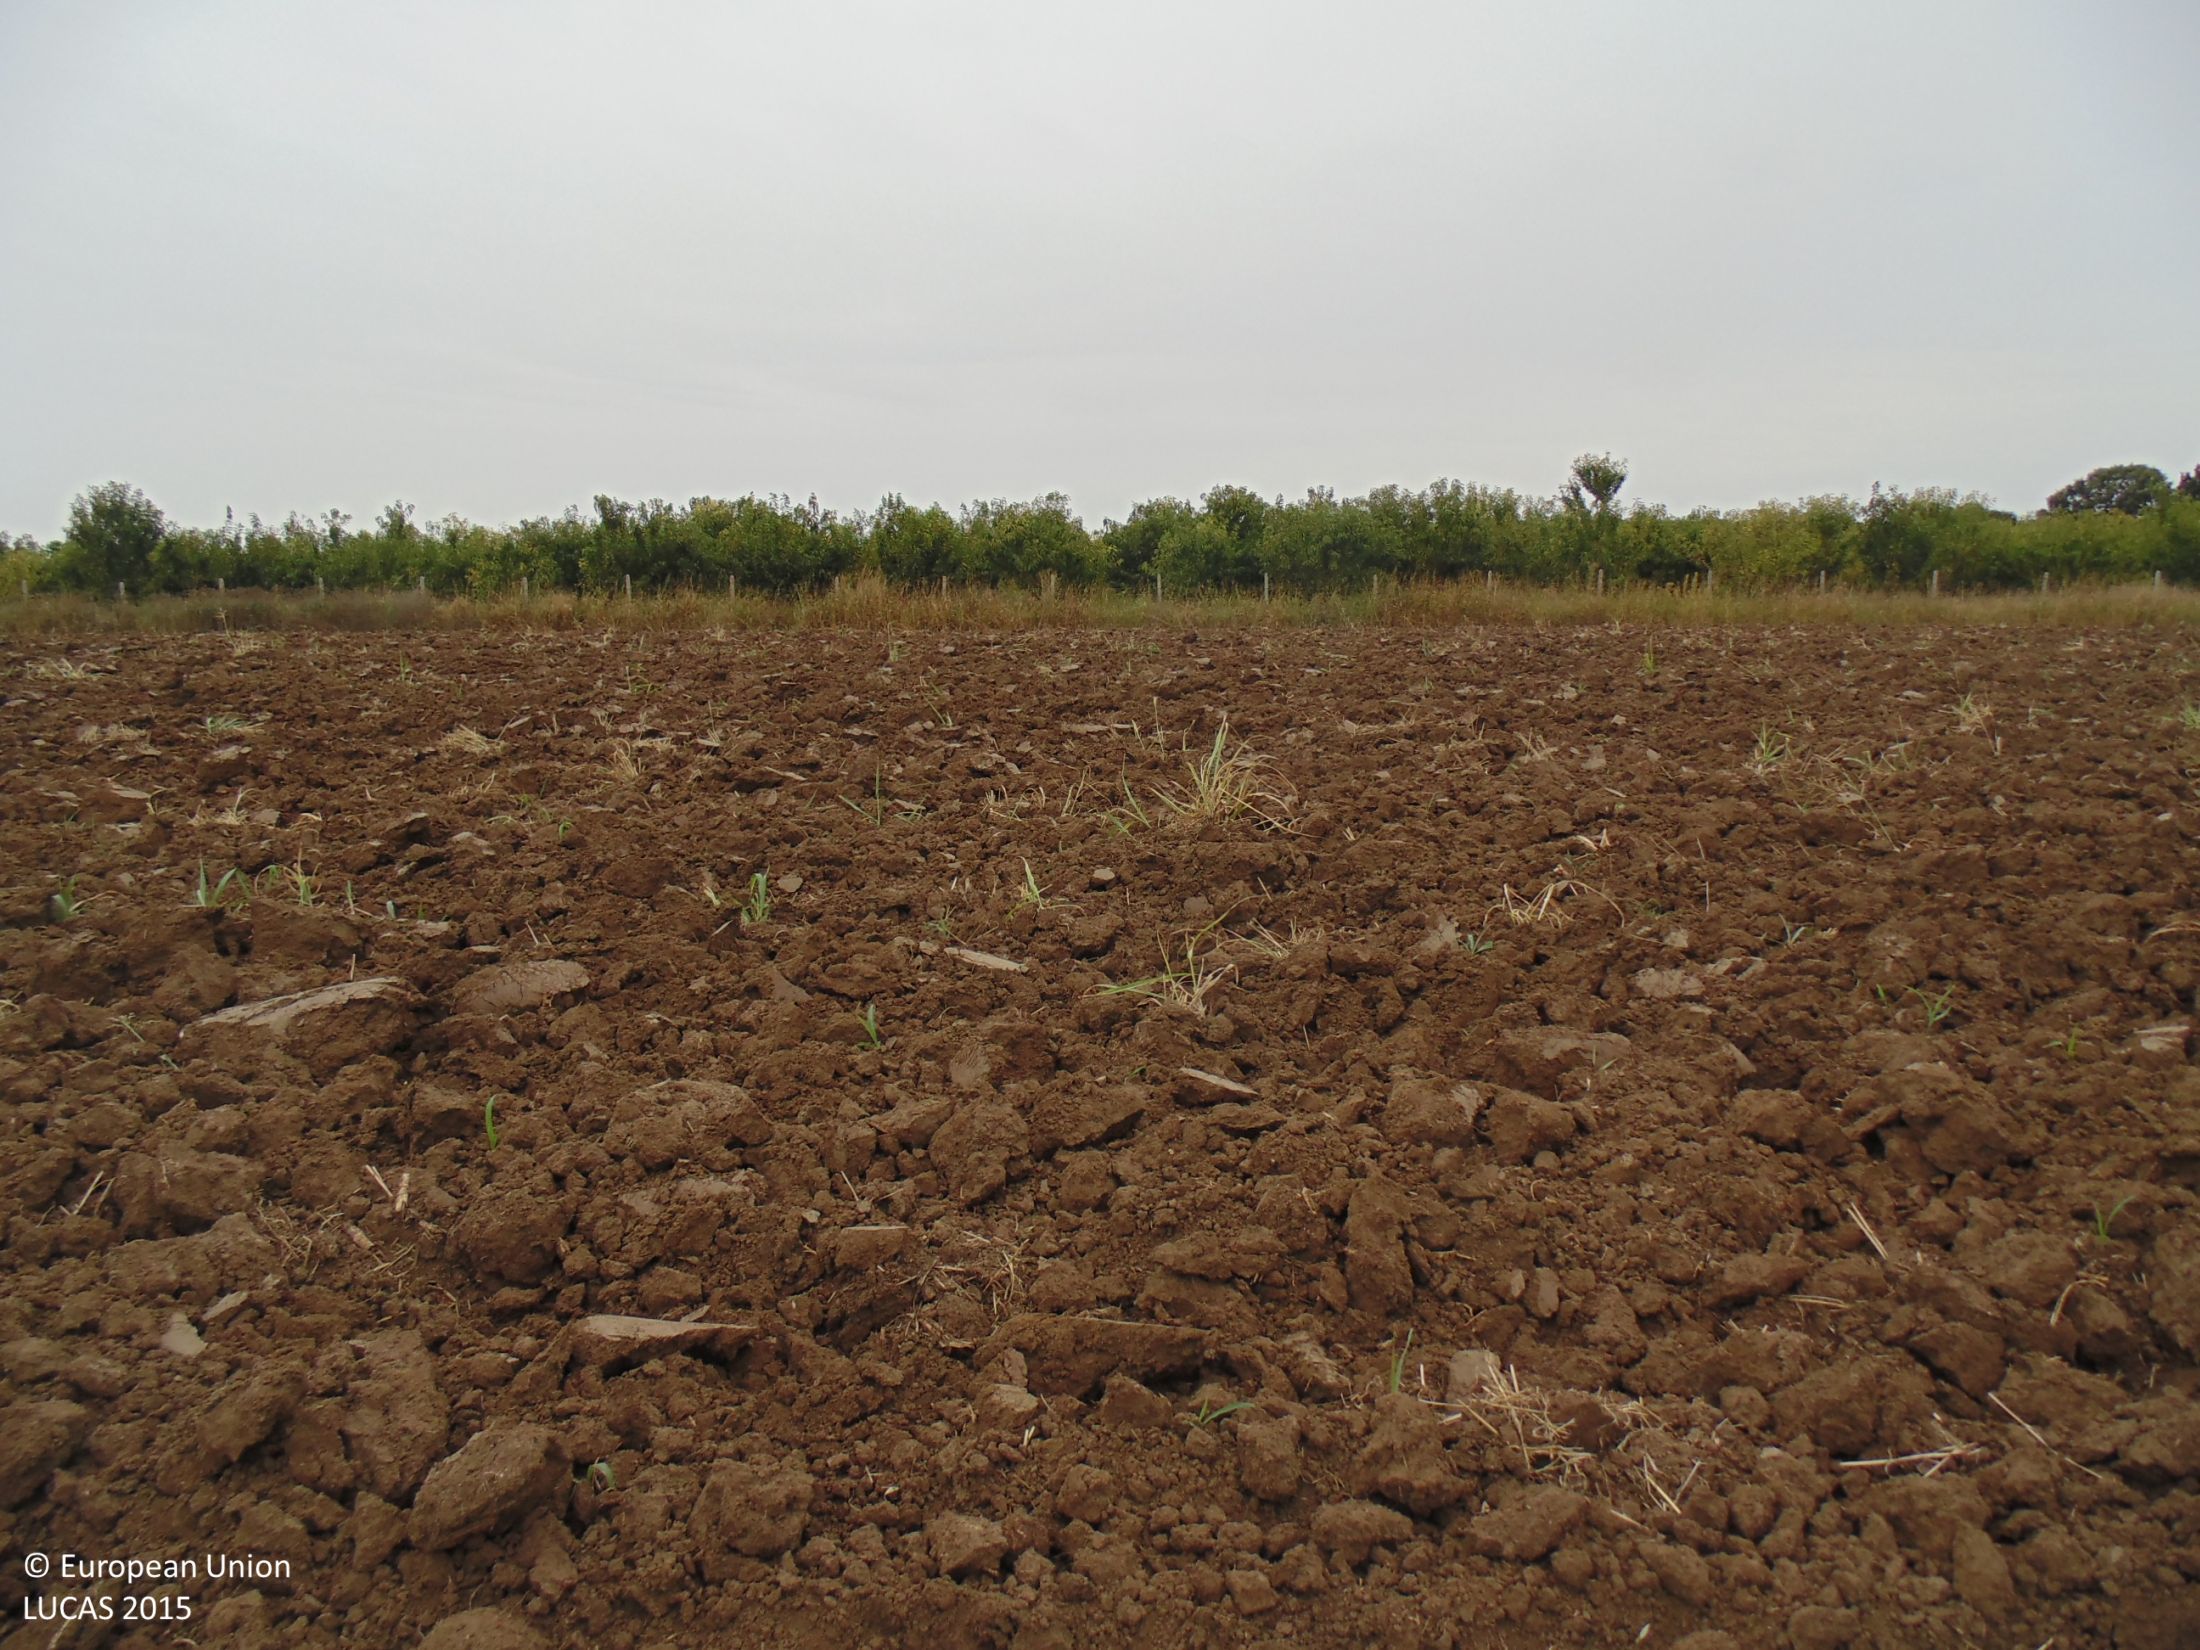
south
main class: Cropland
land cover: Common wheat
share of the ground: < 10 %
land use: Agriculture (excluding fallow land and kitchen gardens)
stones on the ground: < 10 %
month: September
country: BG
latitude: 43.9504
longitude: 26.9813
